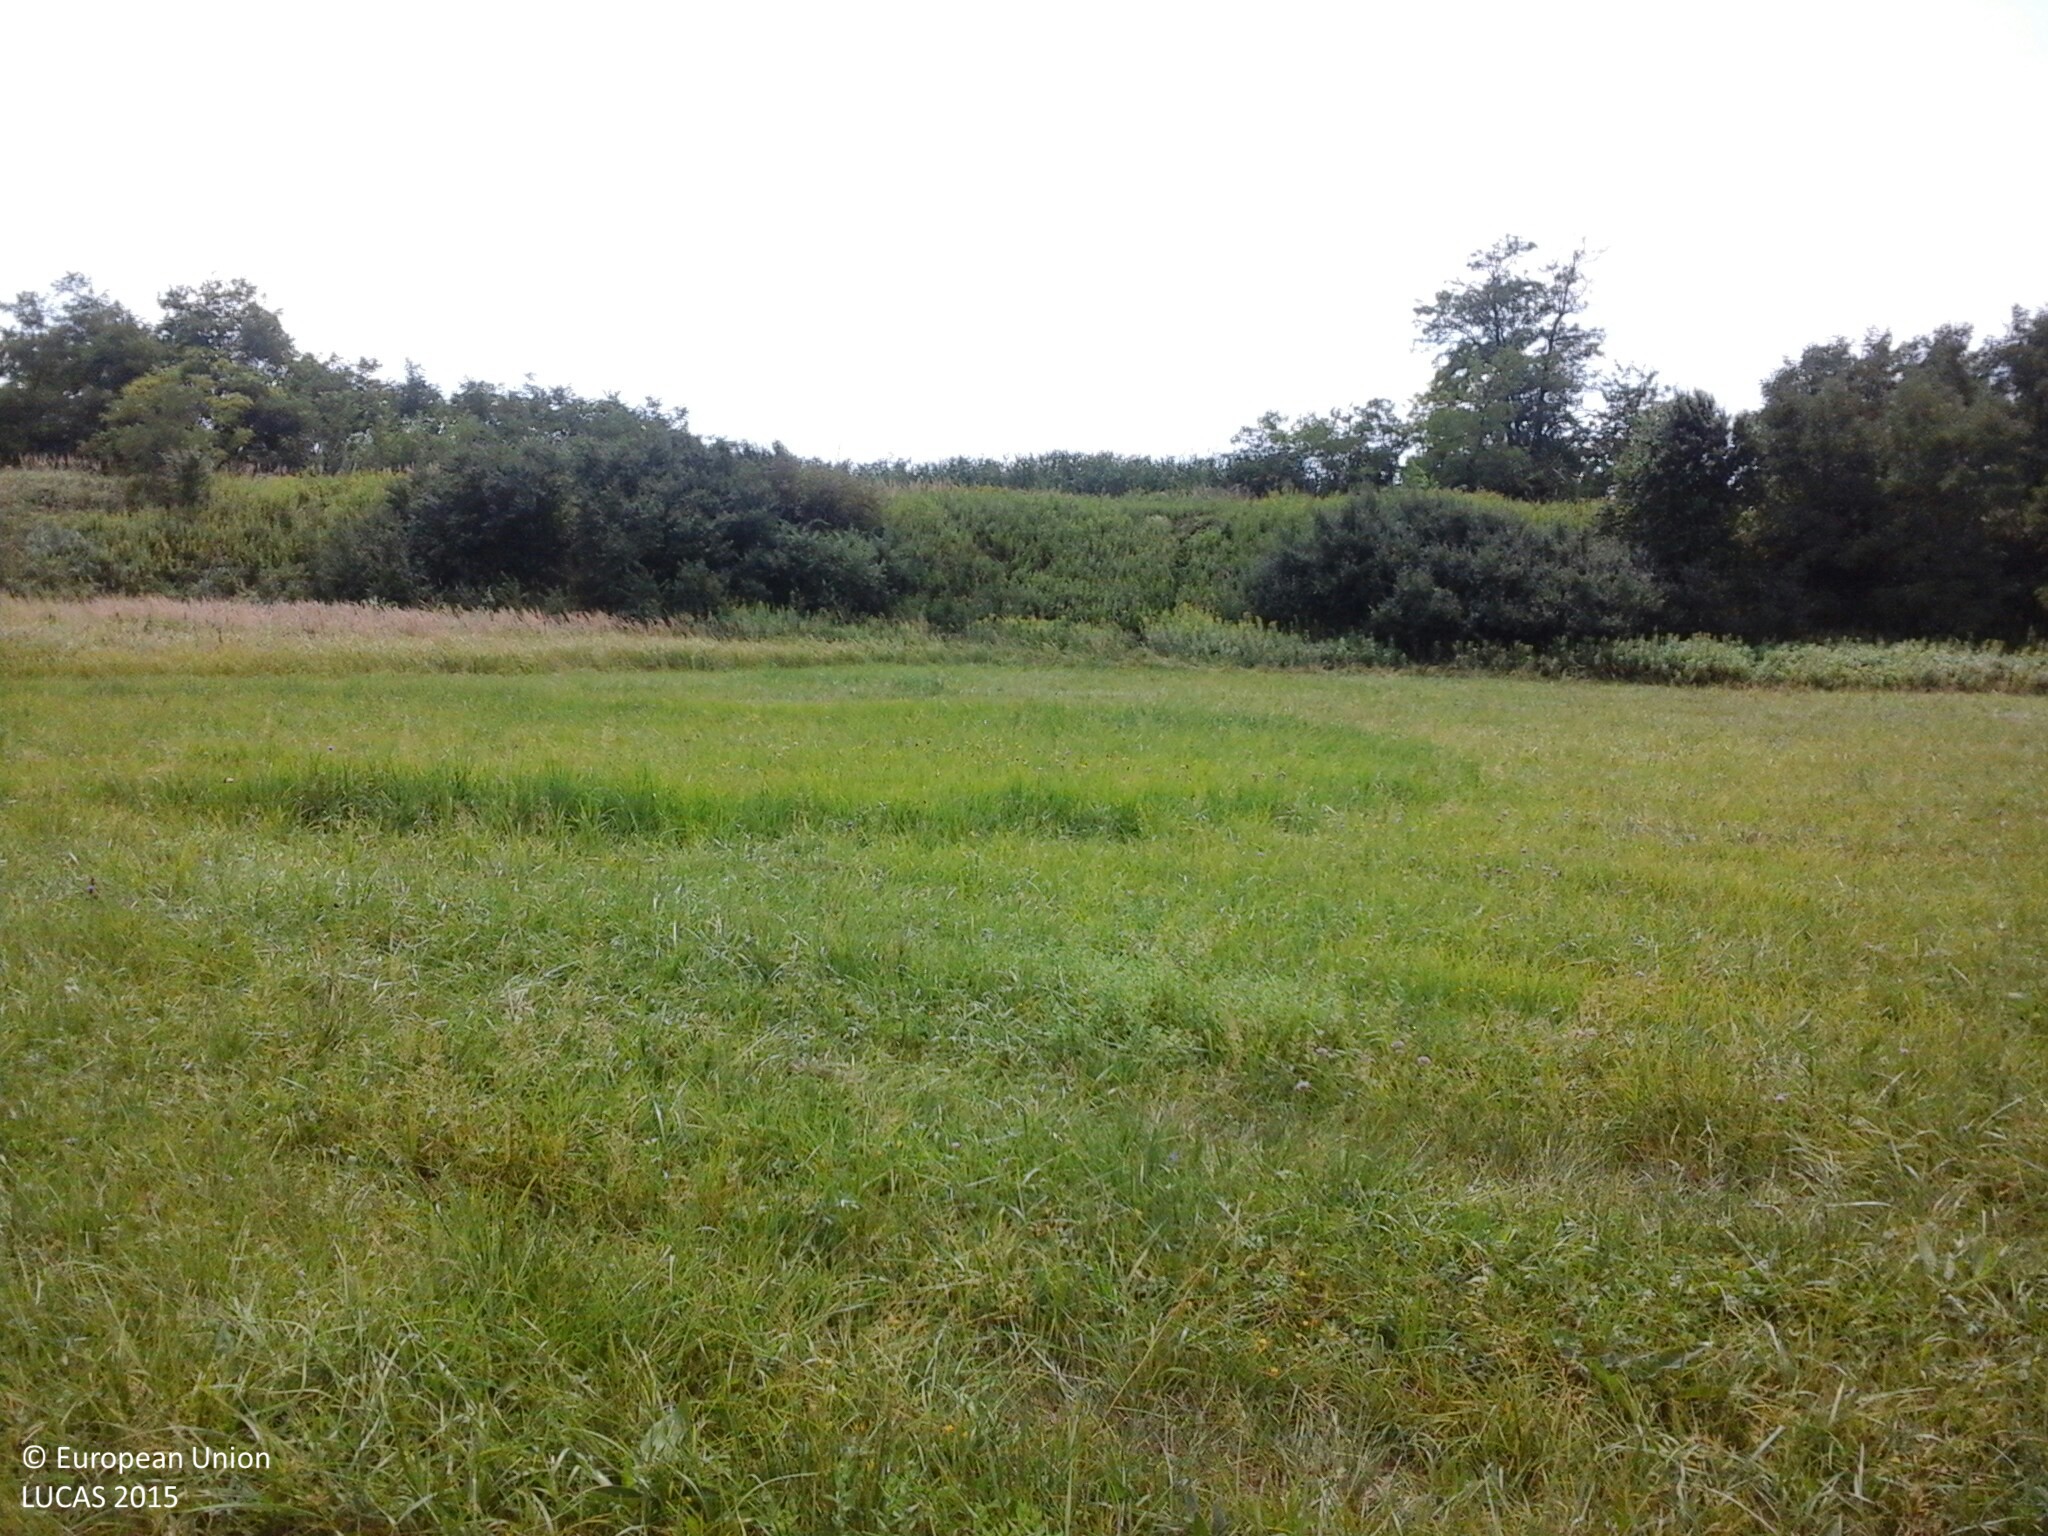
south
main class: Grassland
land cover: Grassland without tree/shrub cover
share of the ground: > 75 %
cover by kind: herbaceous plants 100 %
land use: Semi-natural and natural areas not in use
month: August
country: HU
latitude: 47.3565
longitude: 18.2066
